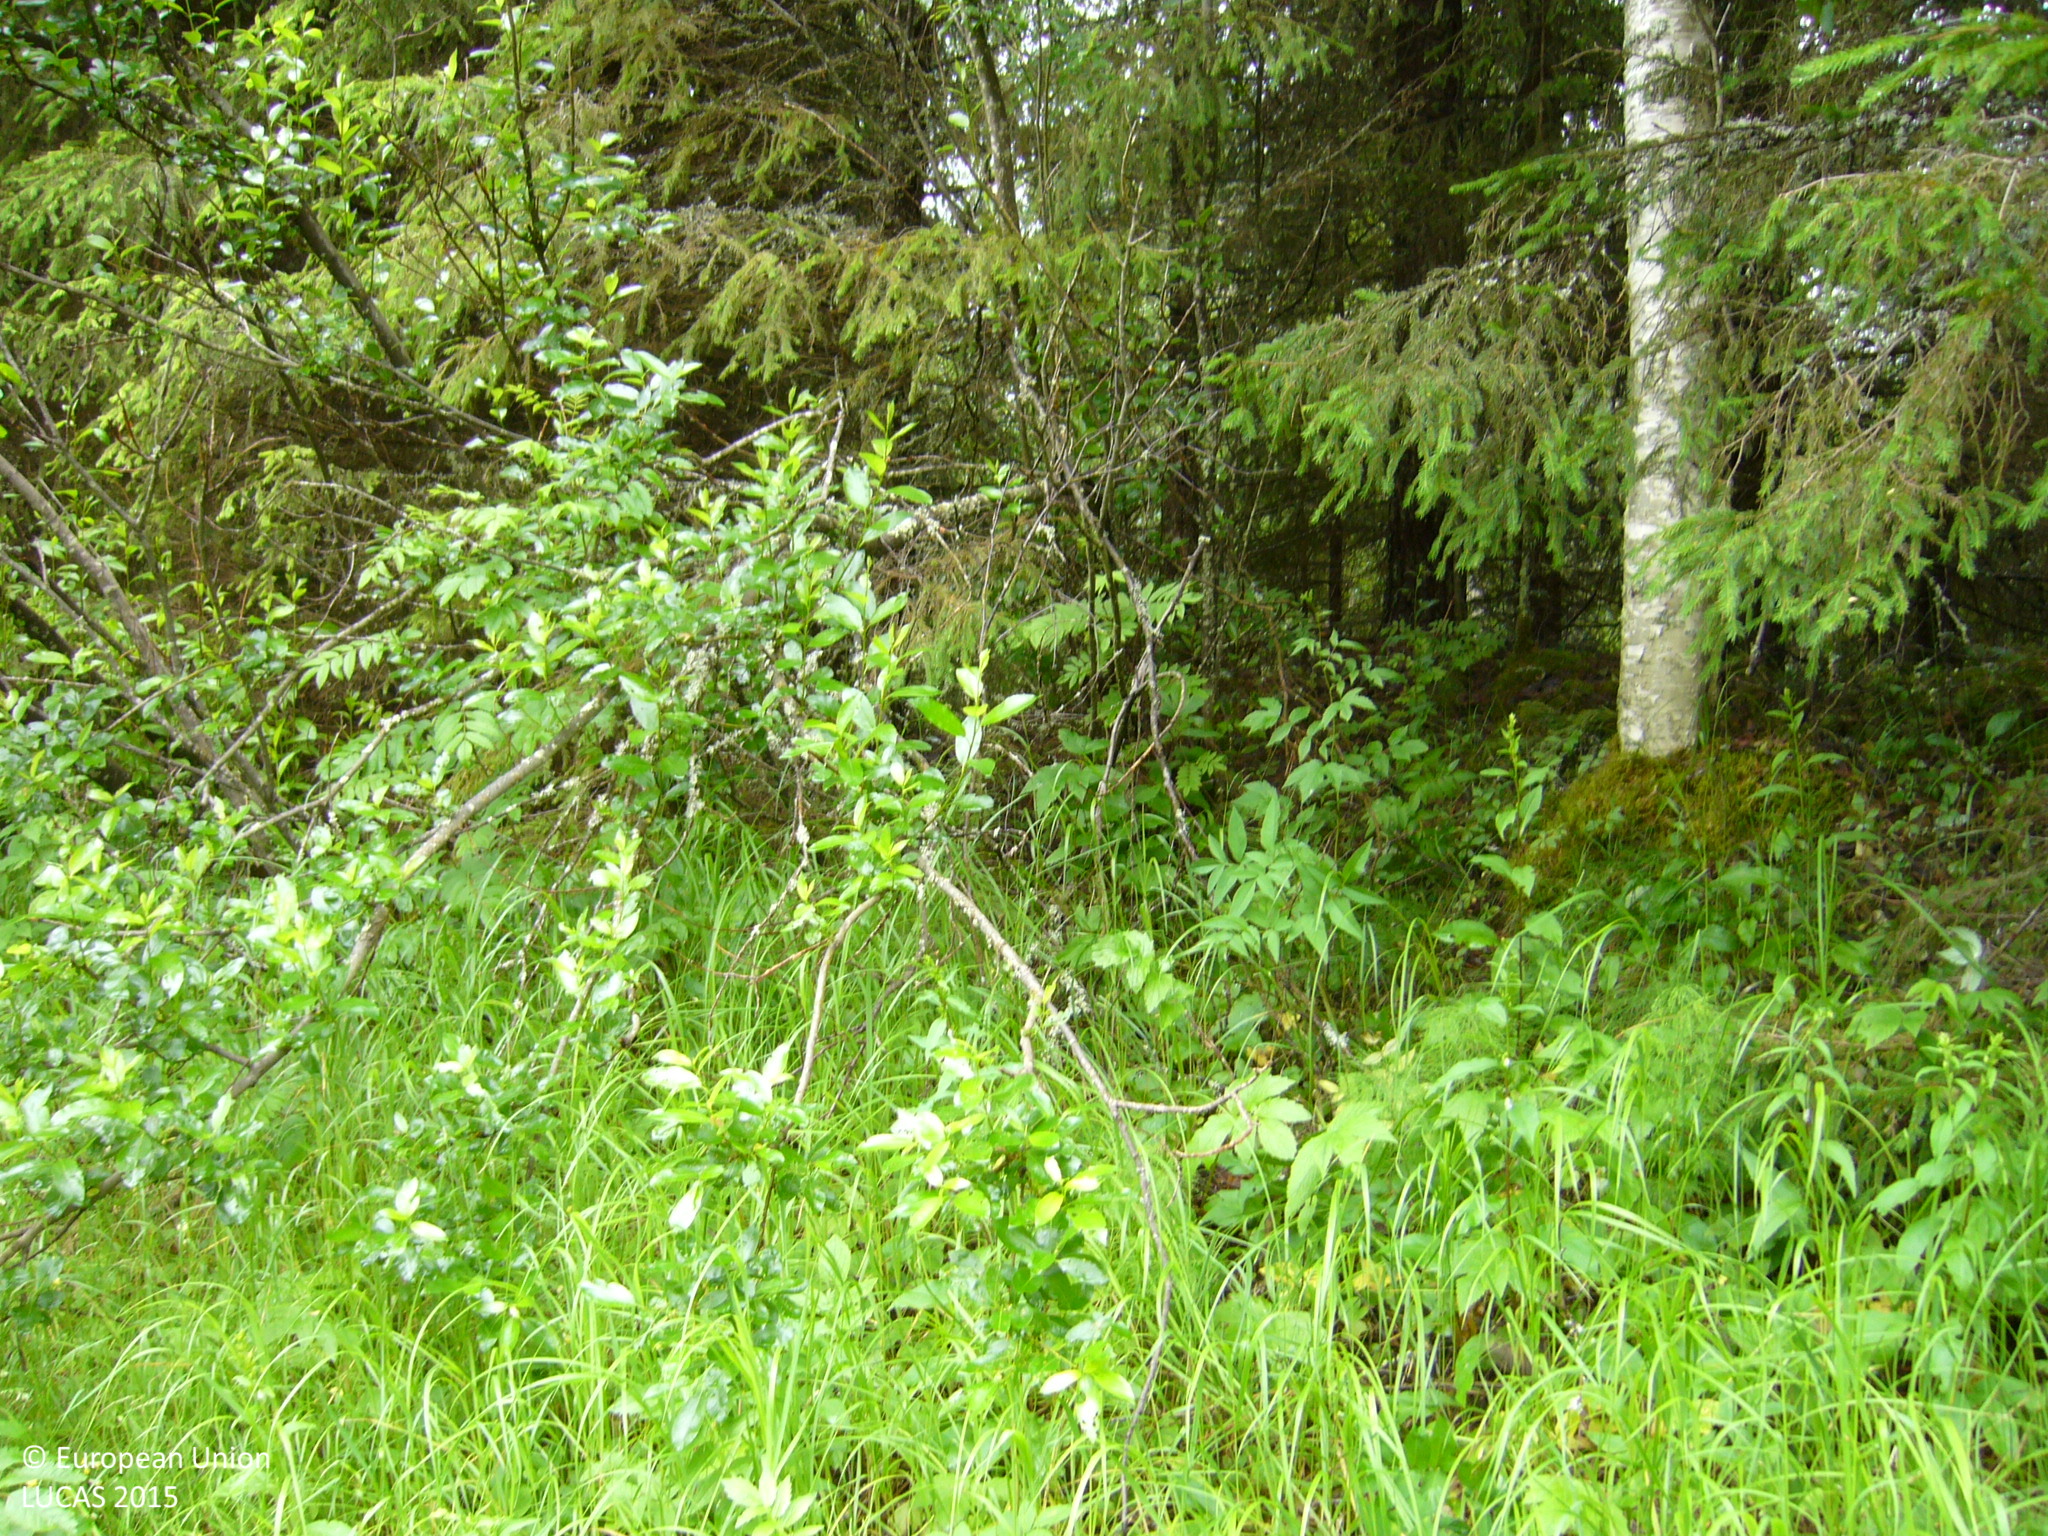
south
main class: Woodland
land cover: Spruce dominated mixed woodland
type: boreal forest
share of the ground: > 75 %
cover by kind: coniferous forest trees 60 %, broadleaved forest trees 30 %, shrubs 10 %
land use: Forestry
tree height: > 5 m
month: July
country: FI
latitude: 63.5011
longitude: 25.6742
